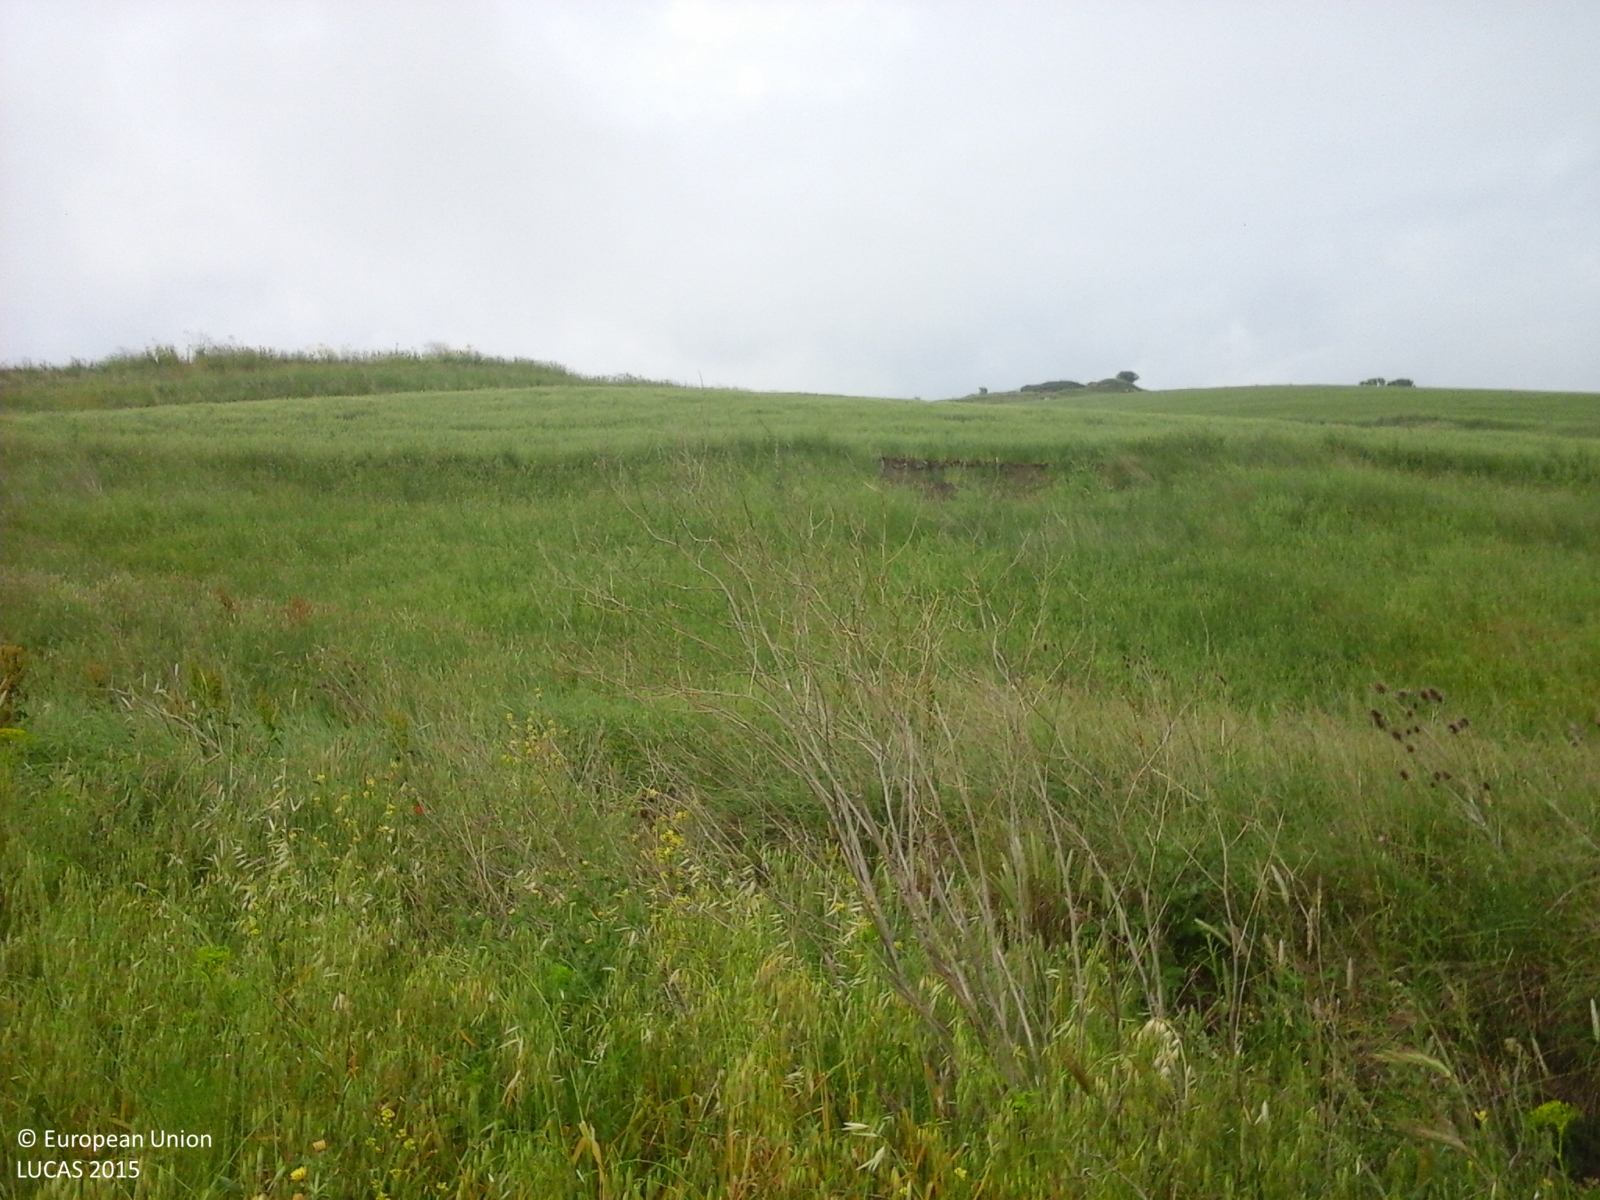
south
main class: Cropland
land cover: Durum wheat
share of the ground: > 75 %
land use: Agriculture (excluding fallow land and kitchen gardens)
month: May
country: IT
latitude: 37.7371
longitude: 13.9769
